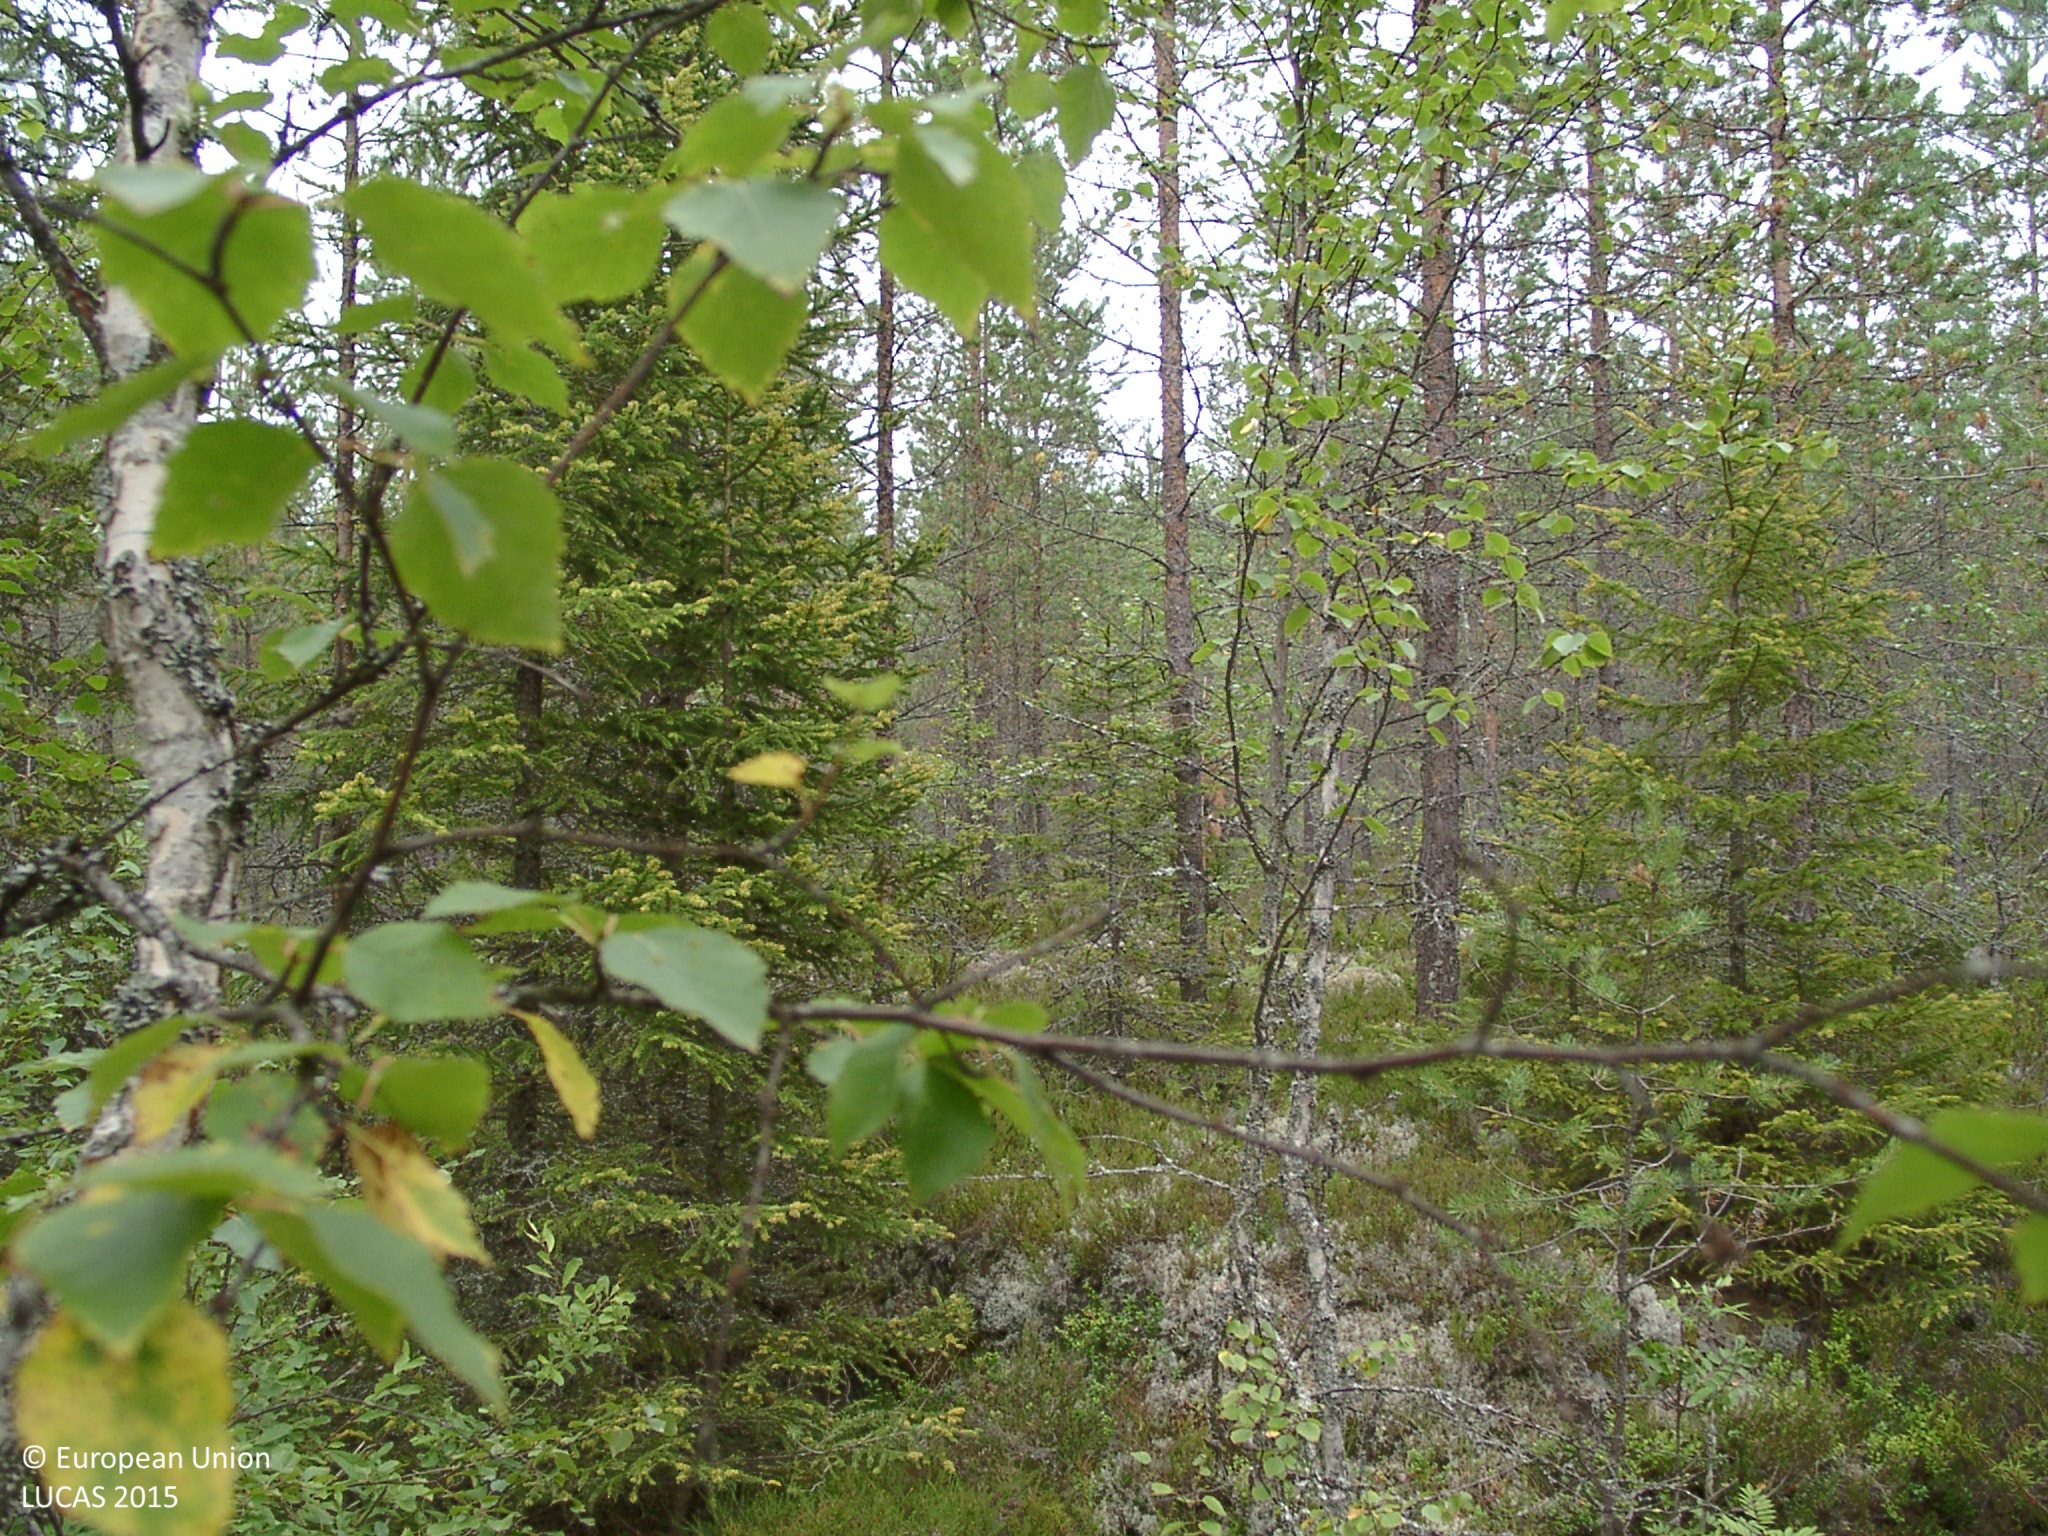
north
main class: Woodland
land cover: Other mixed woodland
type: boreal forest
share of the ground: 25 - 50 %
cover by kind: shrubs 45 %, coniferous forest trees 30 %, lichens and mosses 15 %, broadleaved forest trees 10 %
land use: Forestry
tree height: < 5 m
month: August
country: FI
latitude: 62.6546
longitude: 24.5488
